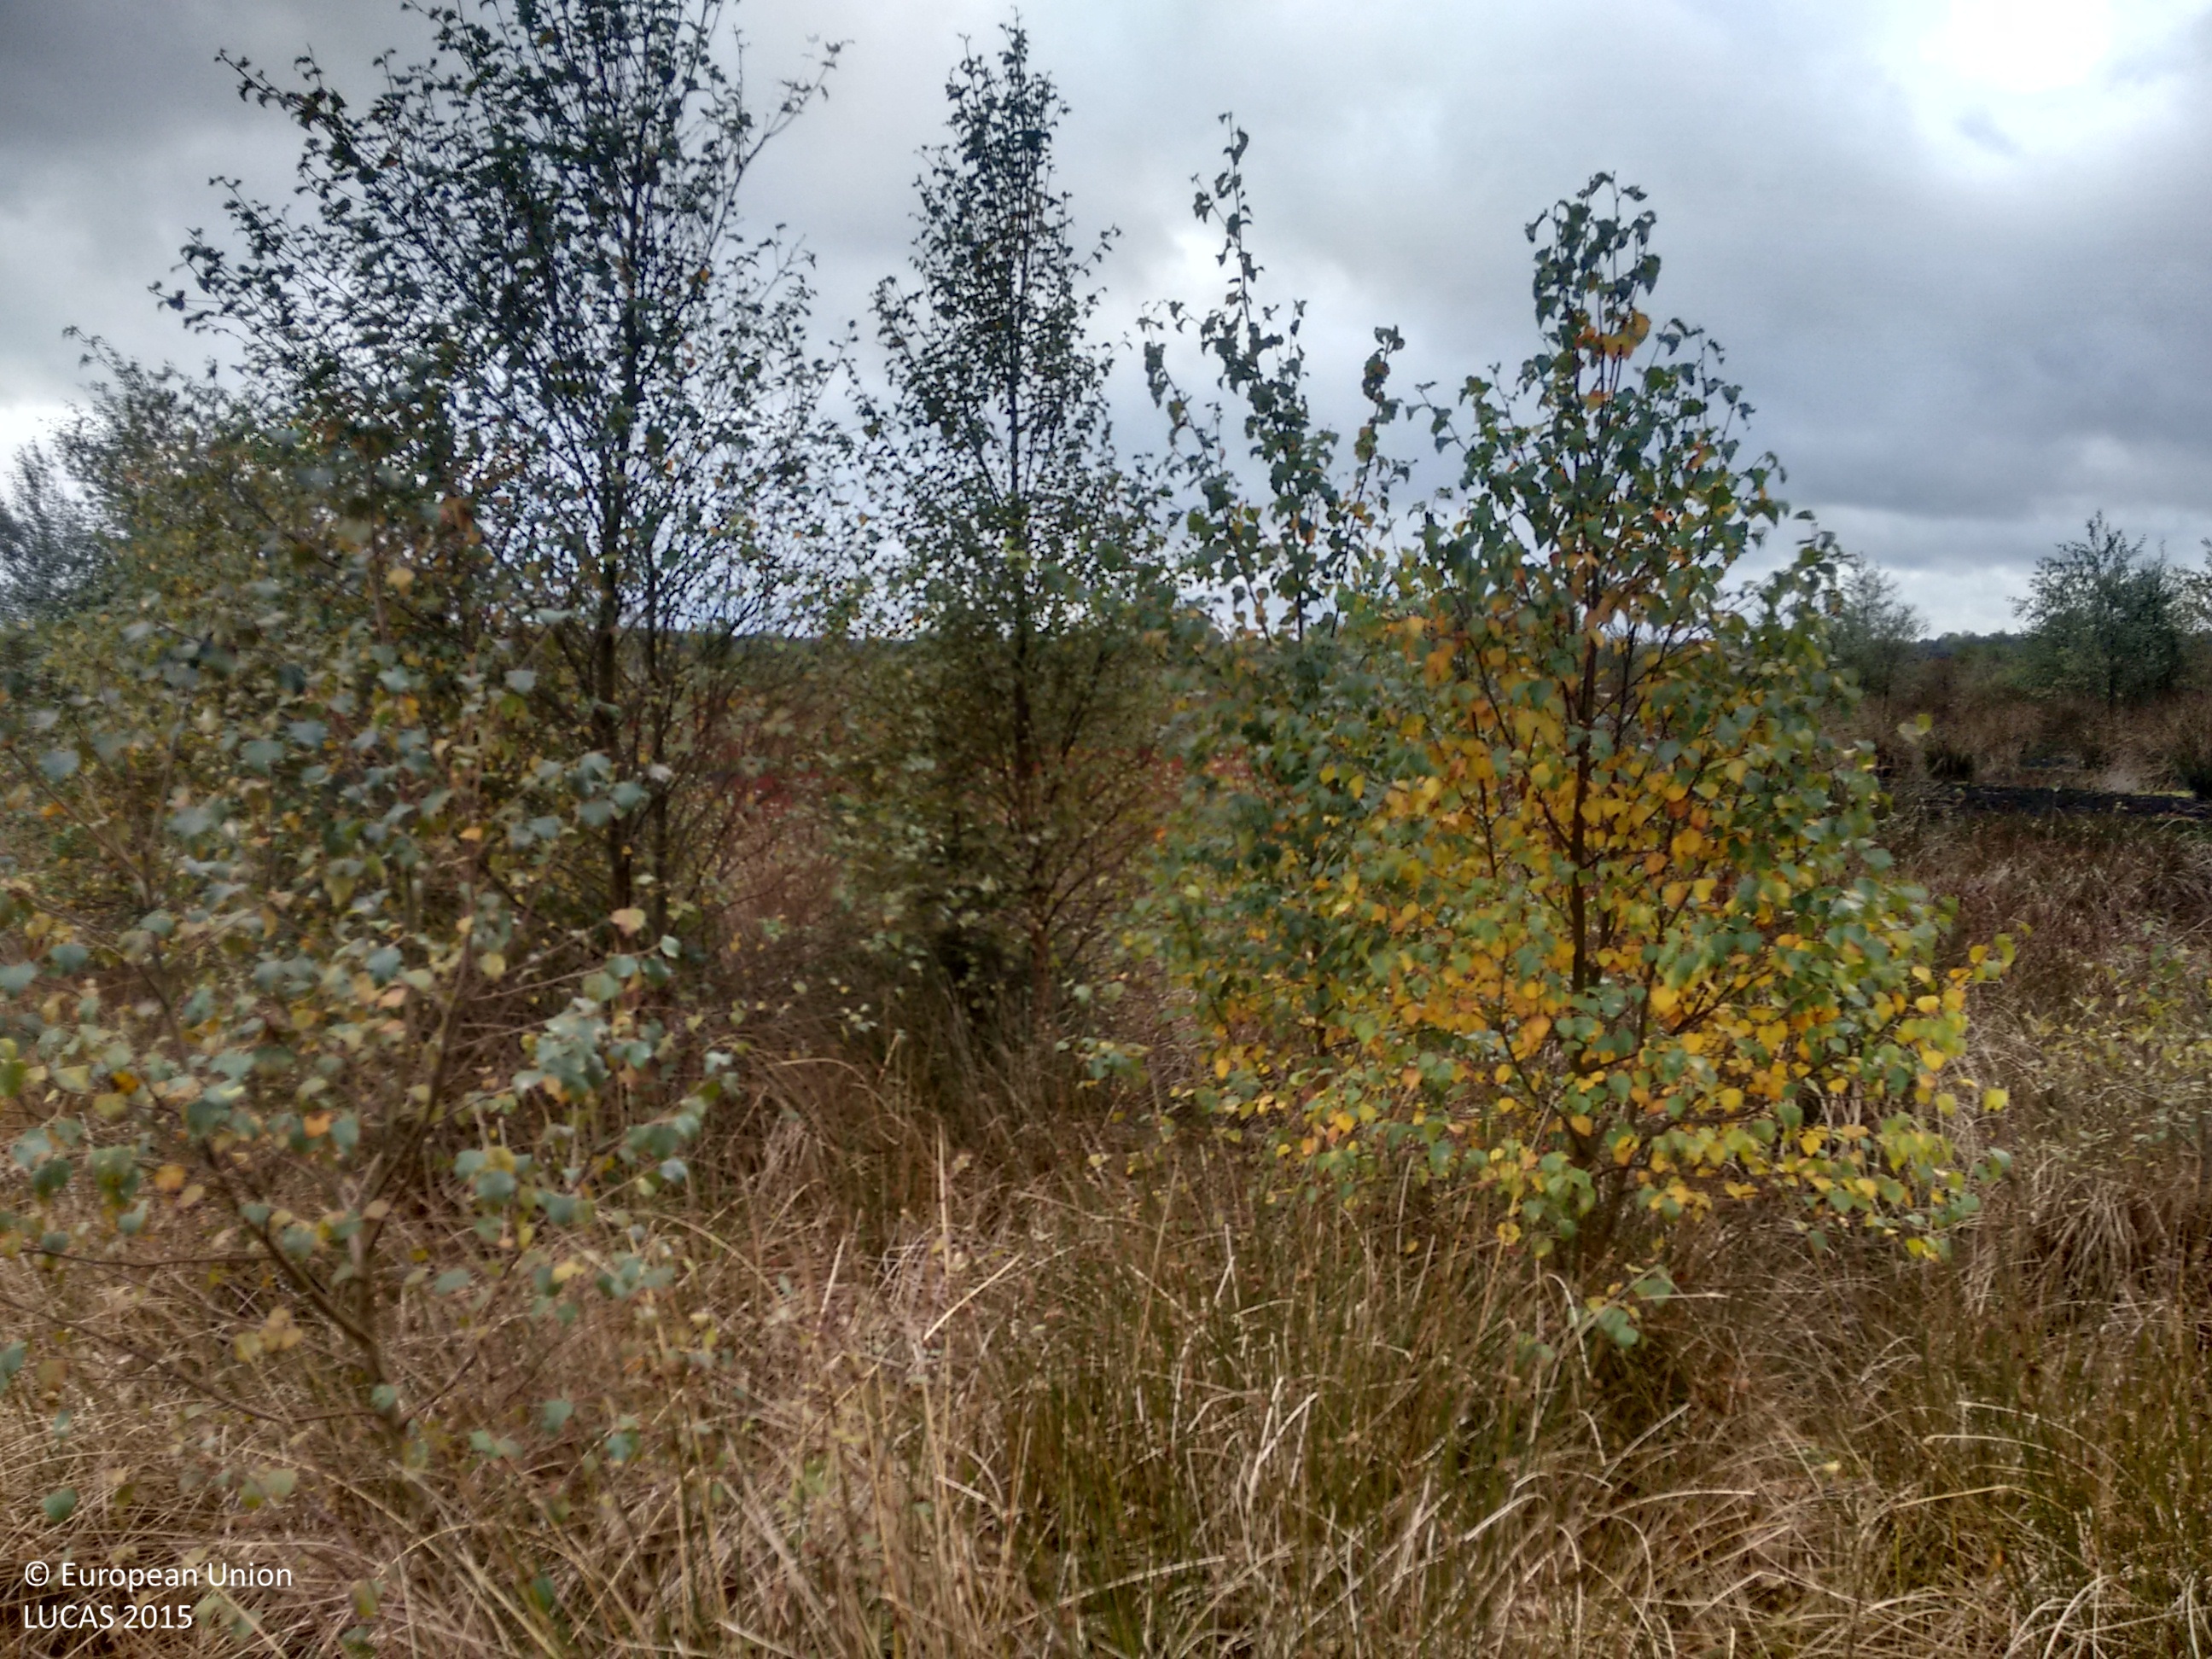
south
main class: Woodland
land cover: Broadleaved woodland
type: acidophilous oak and oak-birch forest
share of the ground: > 75 %
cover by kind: broadleaved forest trees 75 %, herbaceous plants 20 %, lichens and mosses 5 %
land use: Semi-natural and natural areas not in use
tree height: > 5 m
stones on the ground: < 10 %
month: October
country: IE
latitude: 53.1856
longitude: -7.8436
